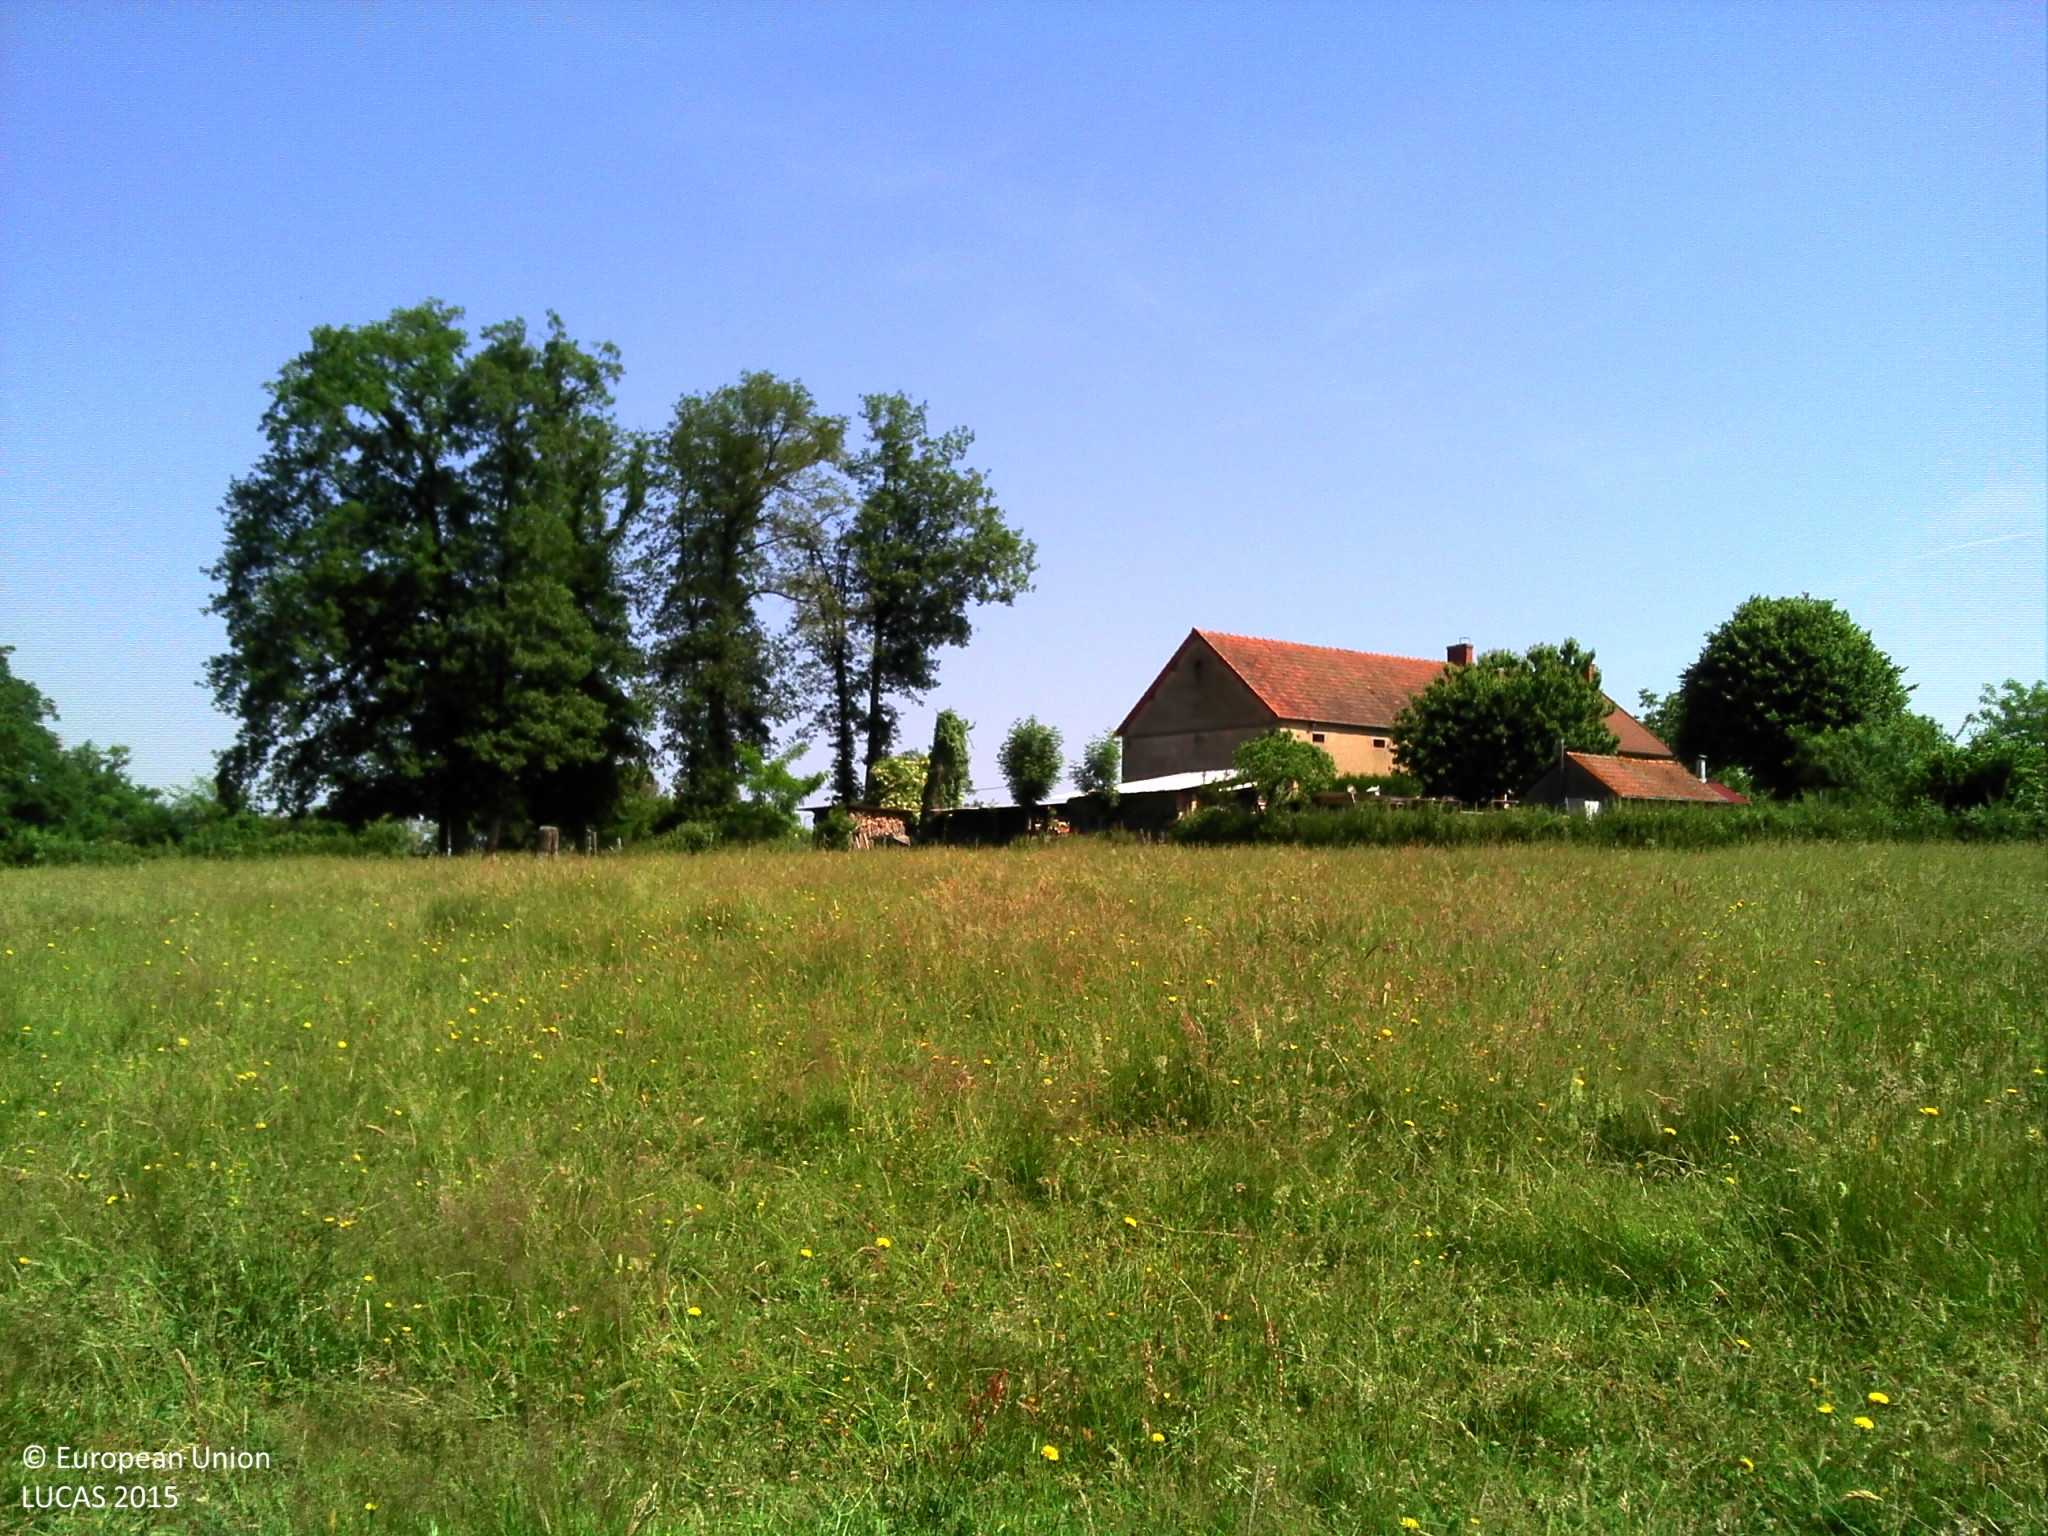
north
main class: Grassland
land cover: Grassland without tree/shrub cover
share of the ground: > 75 %
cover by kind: herbaceous plants 100 %
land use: Agriculture (excluding fallow land and kitchen gardens)
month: June
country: FR
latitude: 46.2350
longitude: 2.8003
